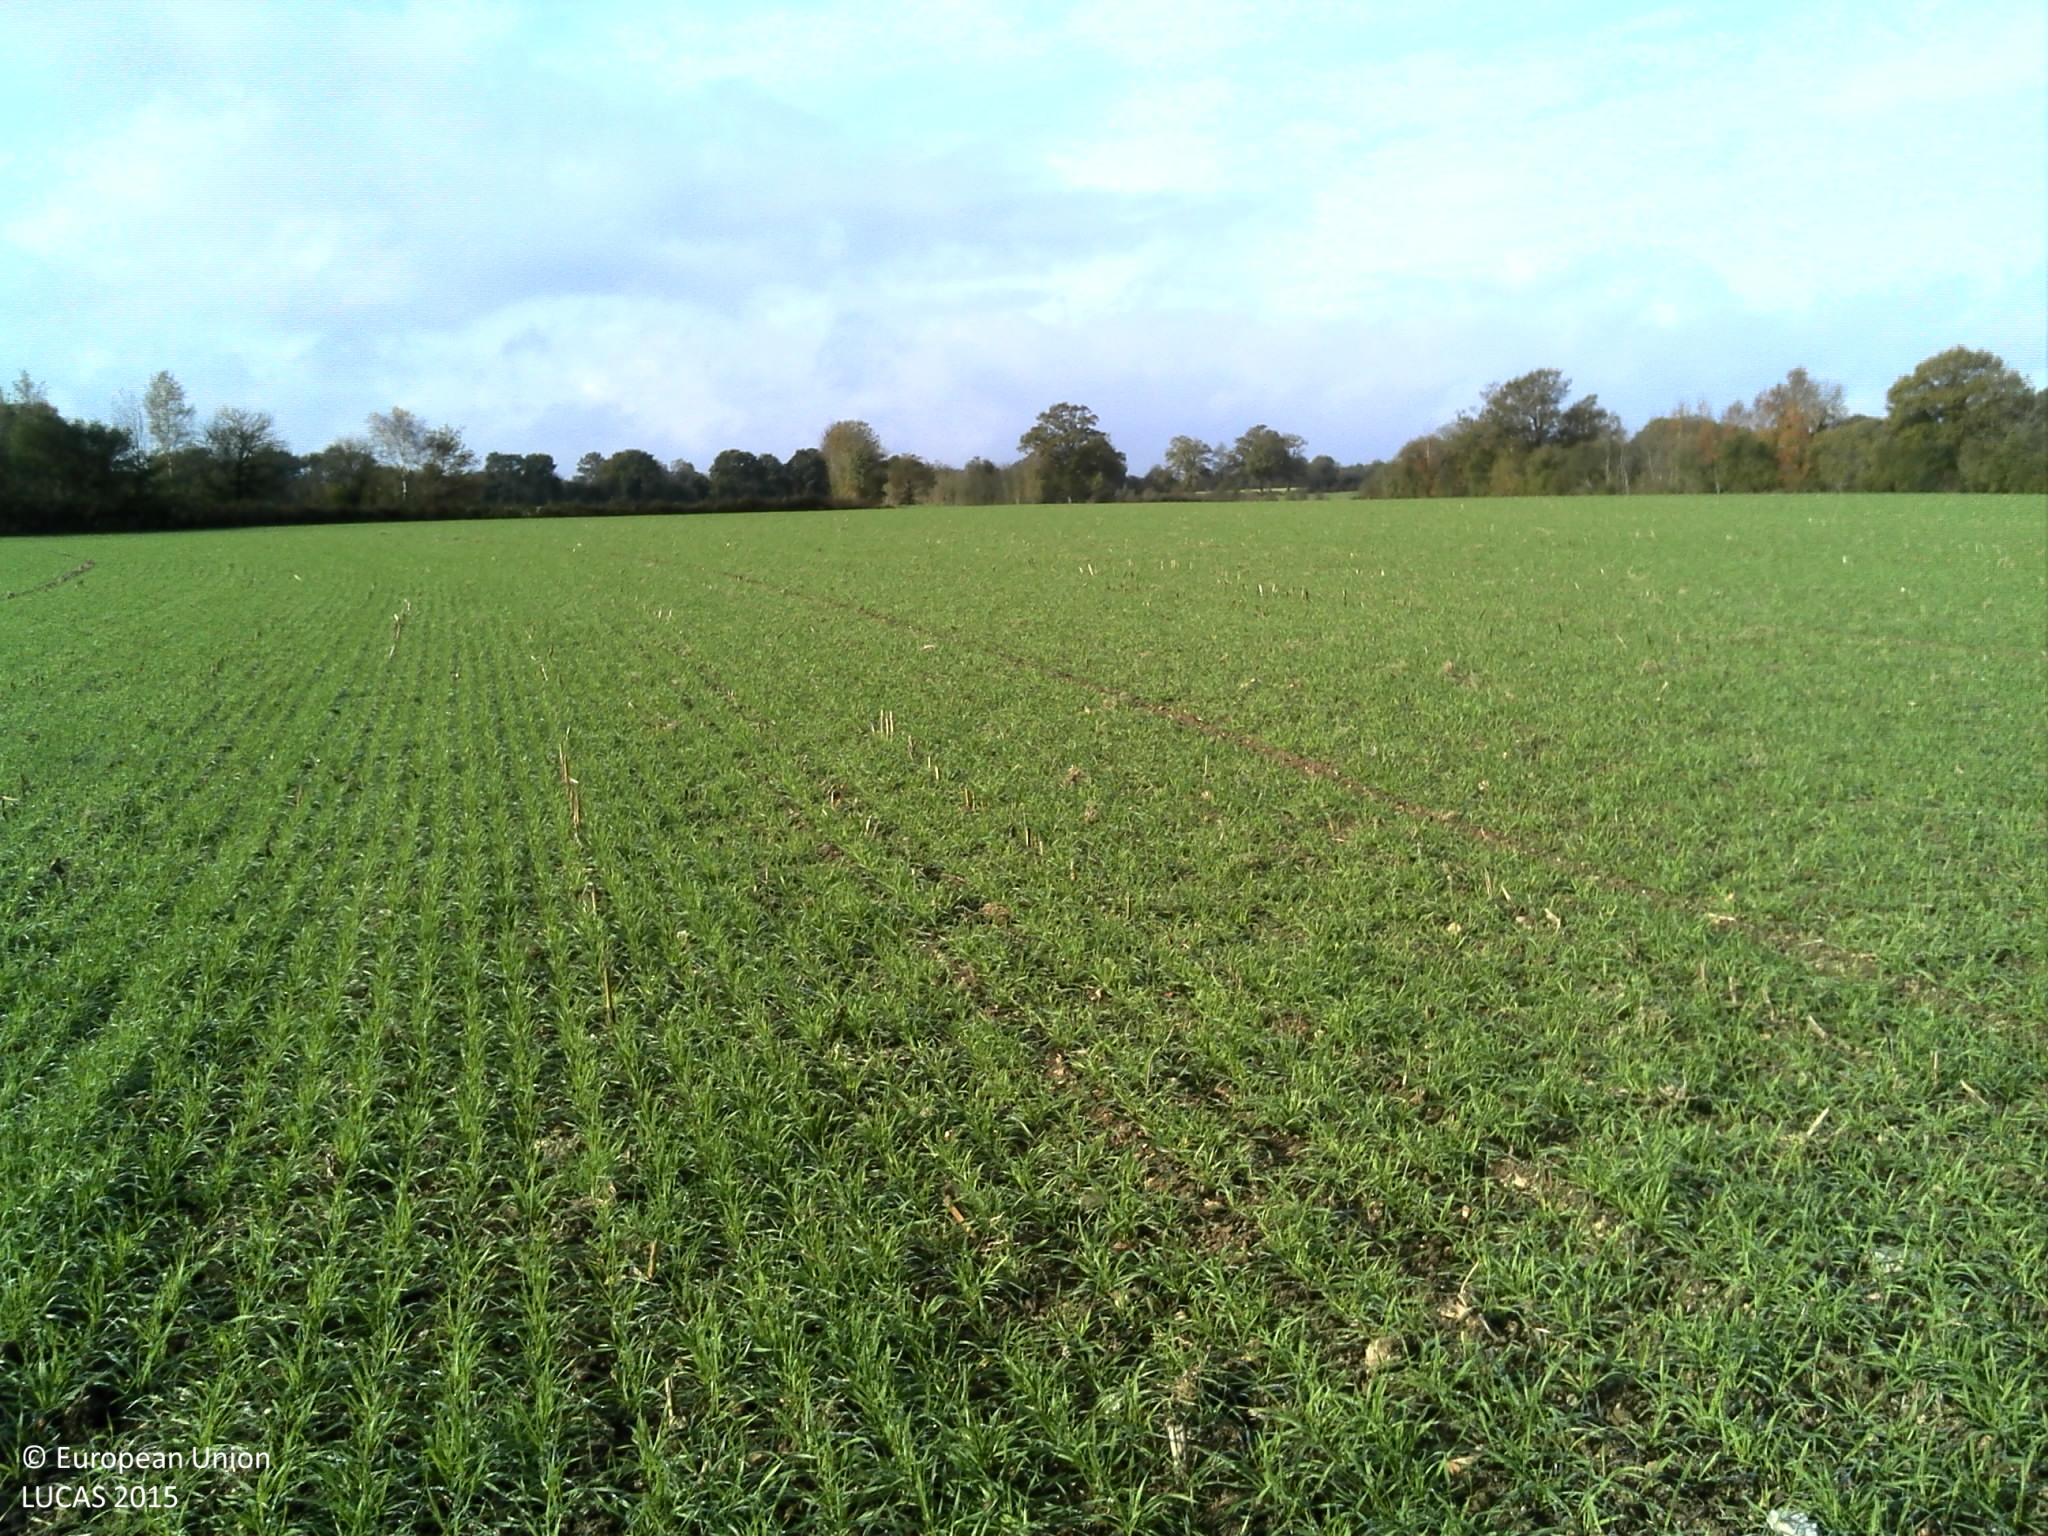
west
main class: Cropland
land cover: Temporary grasslands
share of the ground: > 75 %
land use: Agriculture (excluding fallow land and kitchen gardens)
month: November
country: FR
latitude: 47.3933
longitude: -1.7439
